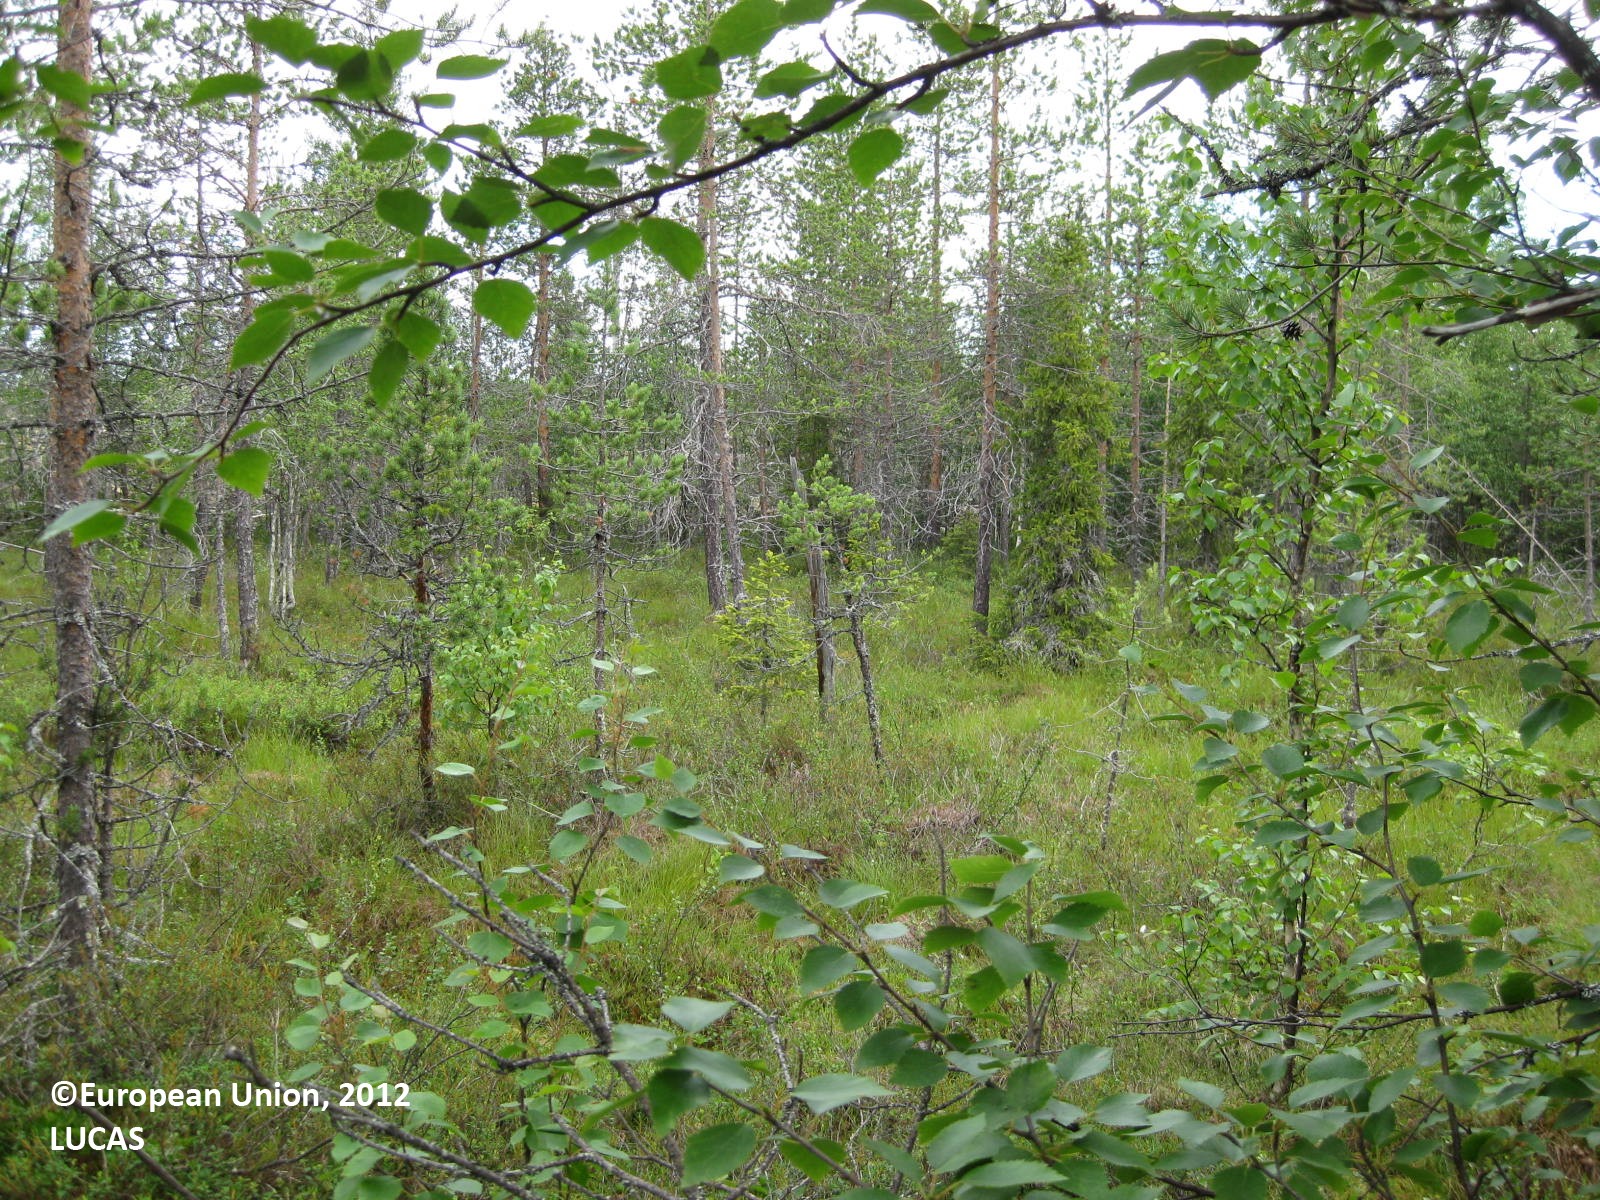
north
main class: Woodland
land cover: Pine dominated mixed woodland
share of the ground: > 75 %
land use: Forestry
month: July
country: FI
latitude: 65.7418
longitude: 29.3176
